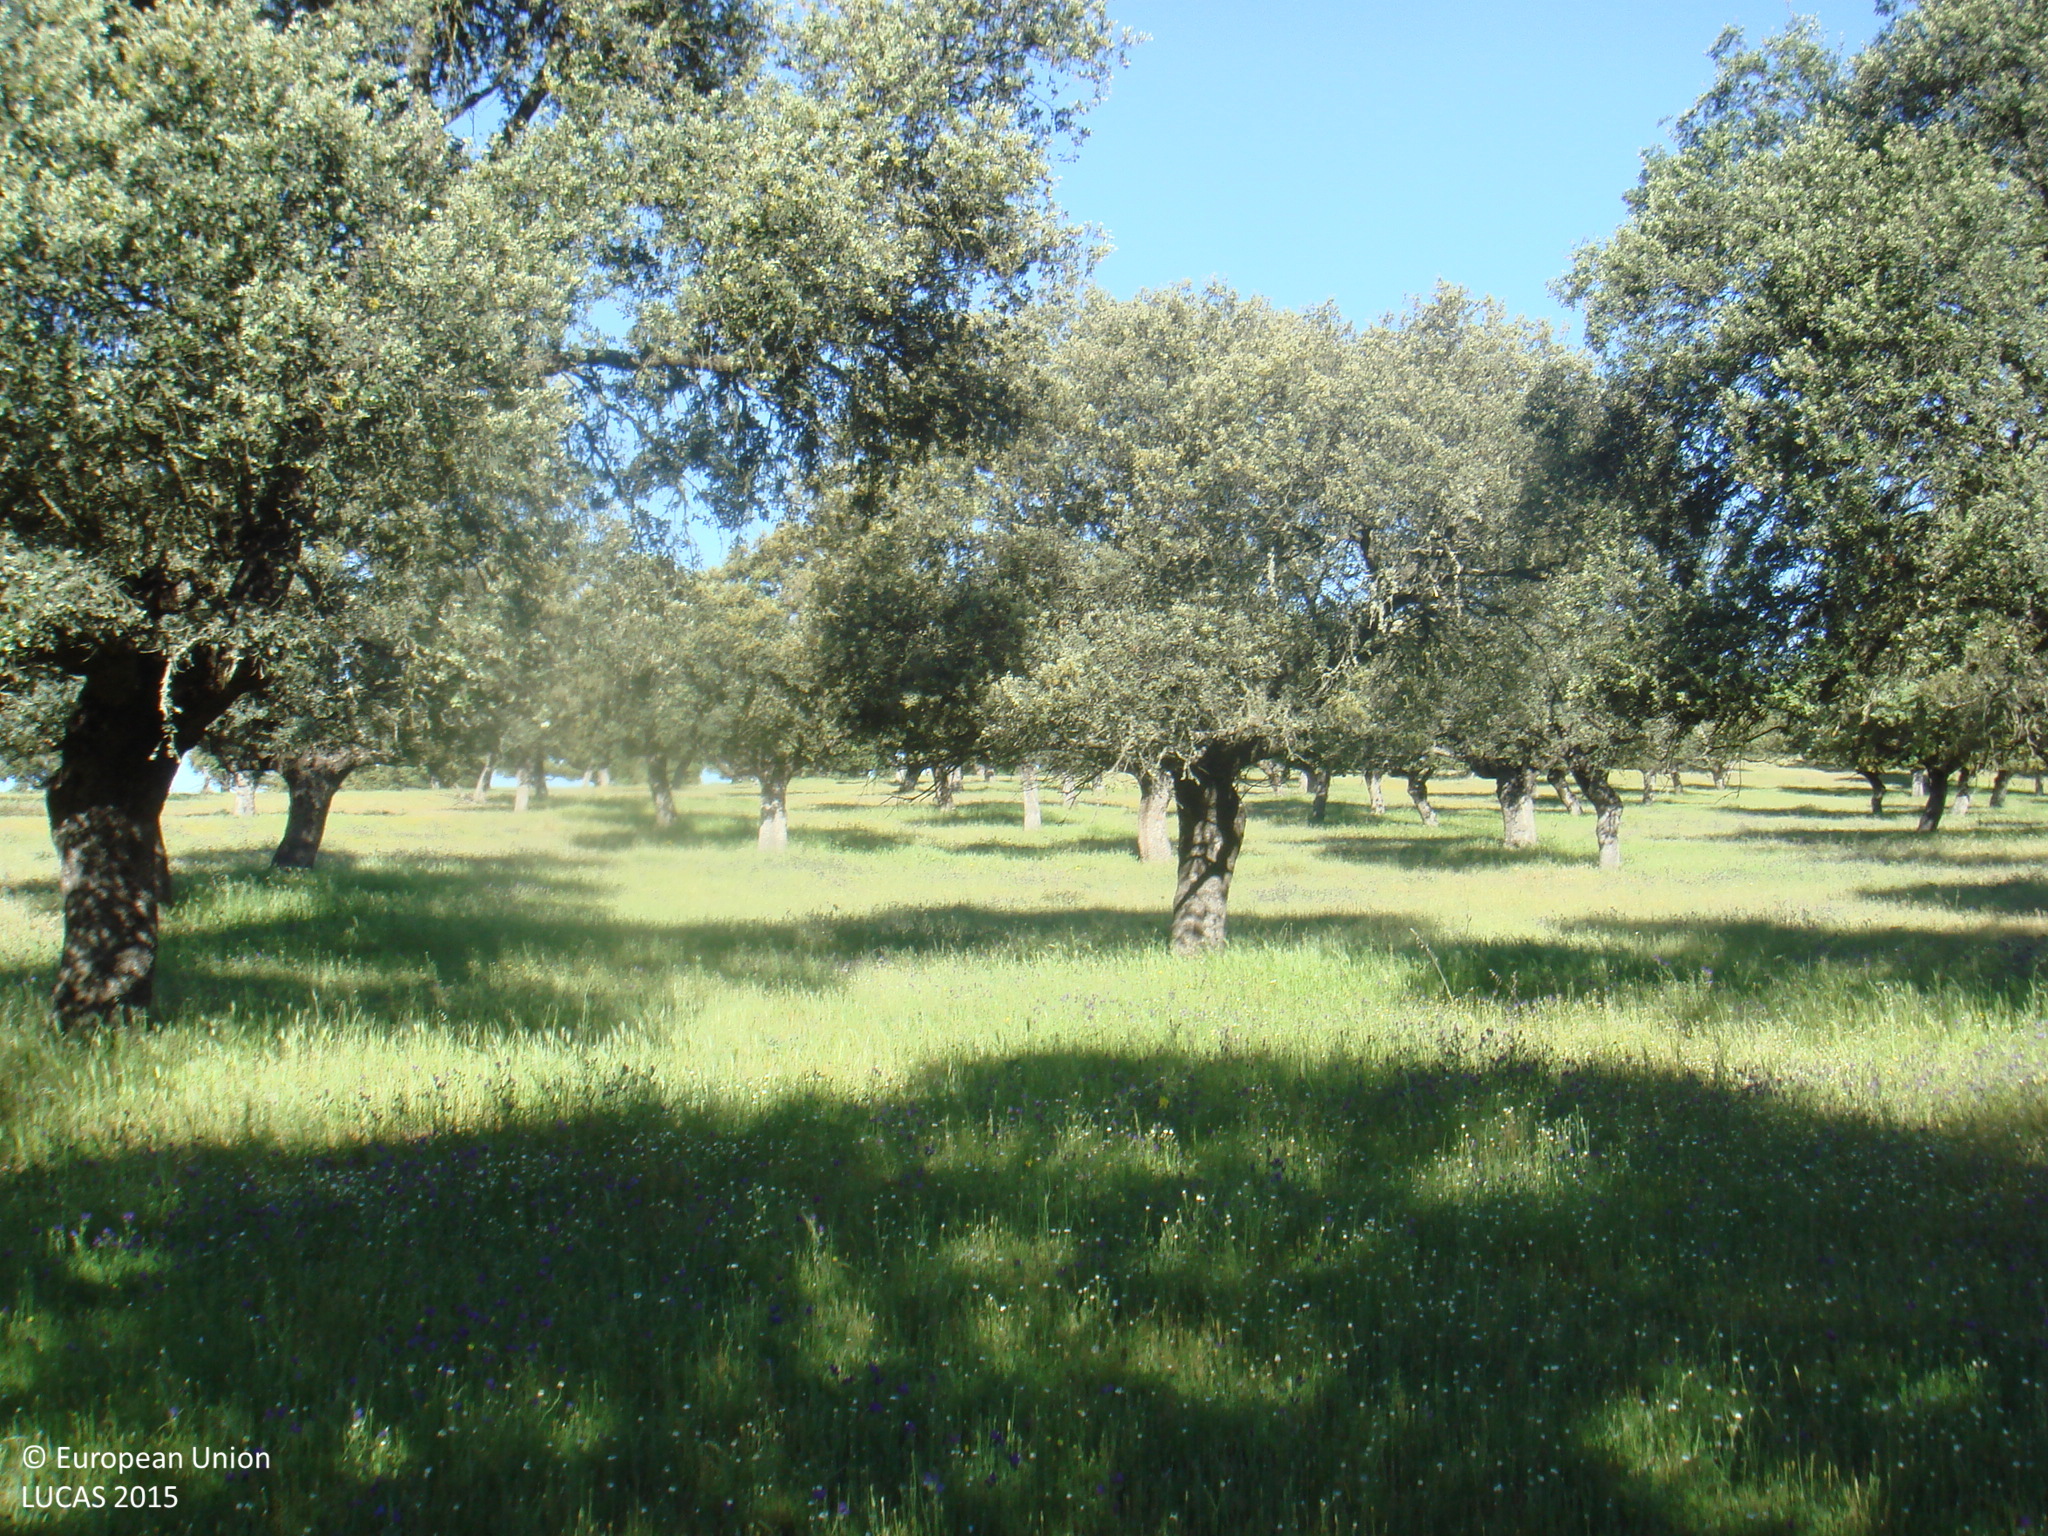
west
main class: Woodland
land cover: Broadleaved woodland
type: broadleaved evergreen forest
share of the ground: 25 - 50 %
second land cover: Spontaneously vegetated surfaces
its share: 50 - 75 %
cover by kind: herbaceous plants 60 %, broadleaved forest trees 40 %
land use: Forestry
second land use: Agriculture (excluding fallow land and kitchen gardens)
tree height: > 5 m
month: May
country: ES
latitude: 38.3559
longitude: -4.7496
